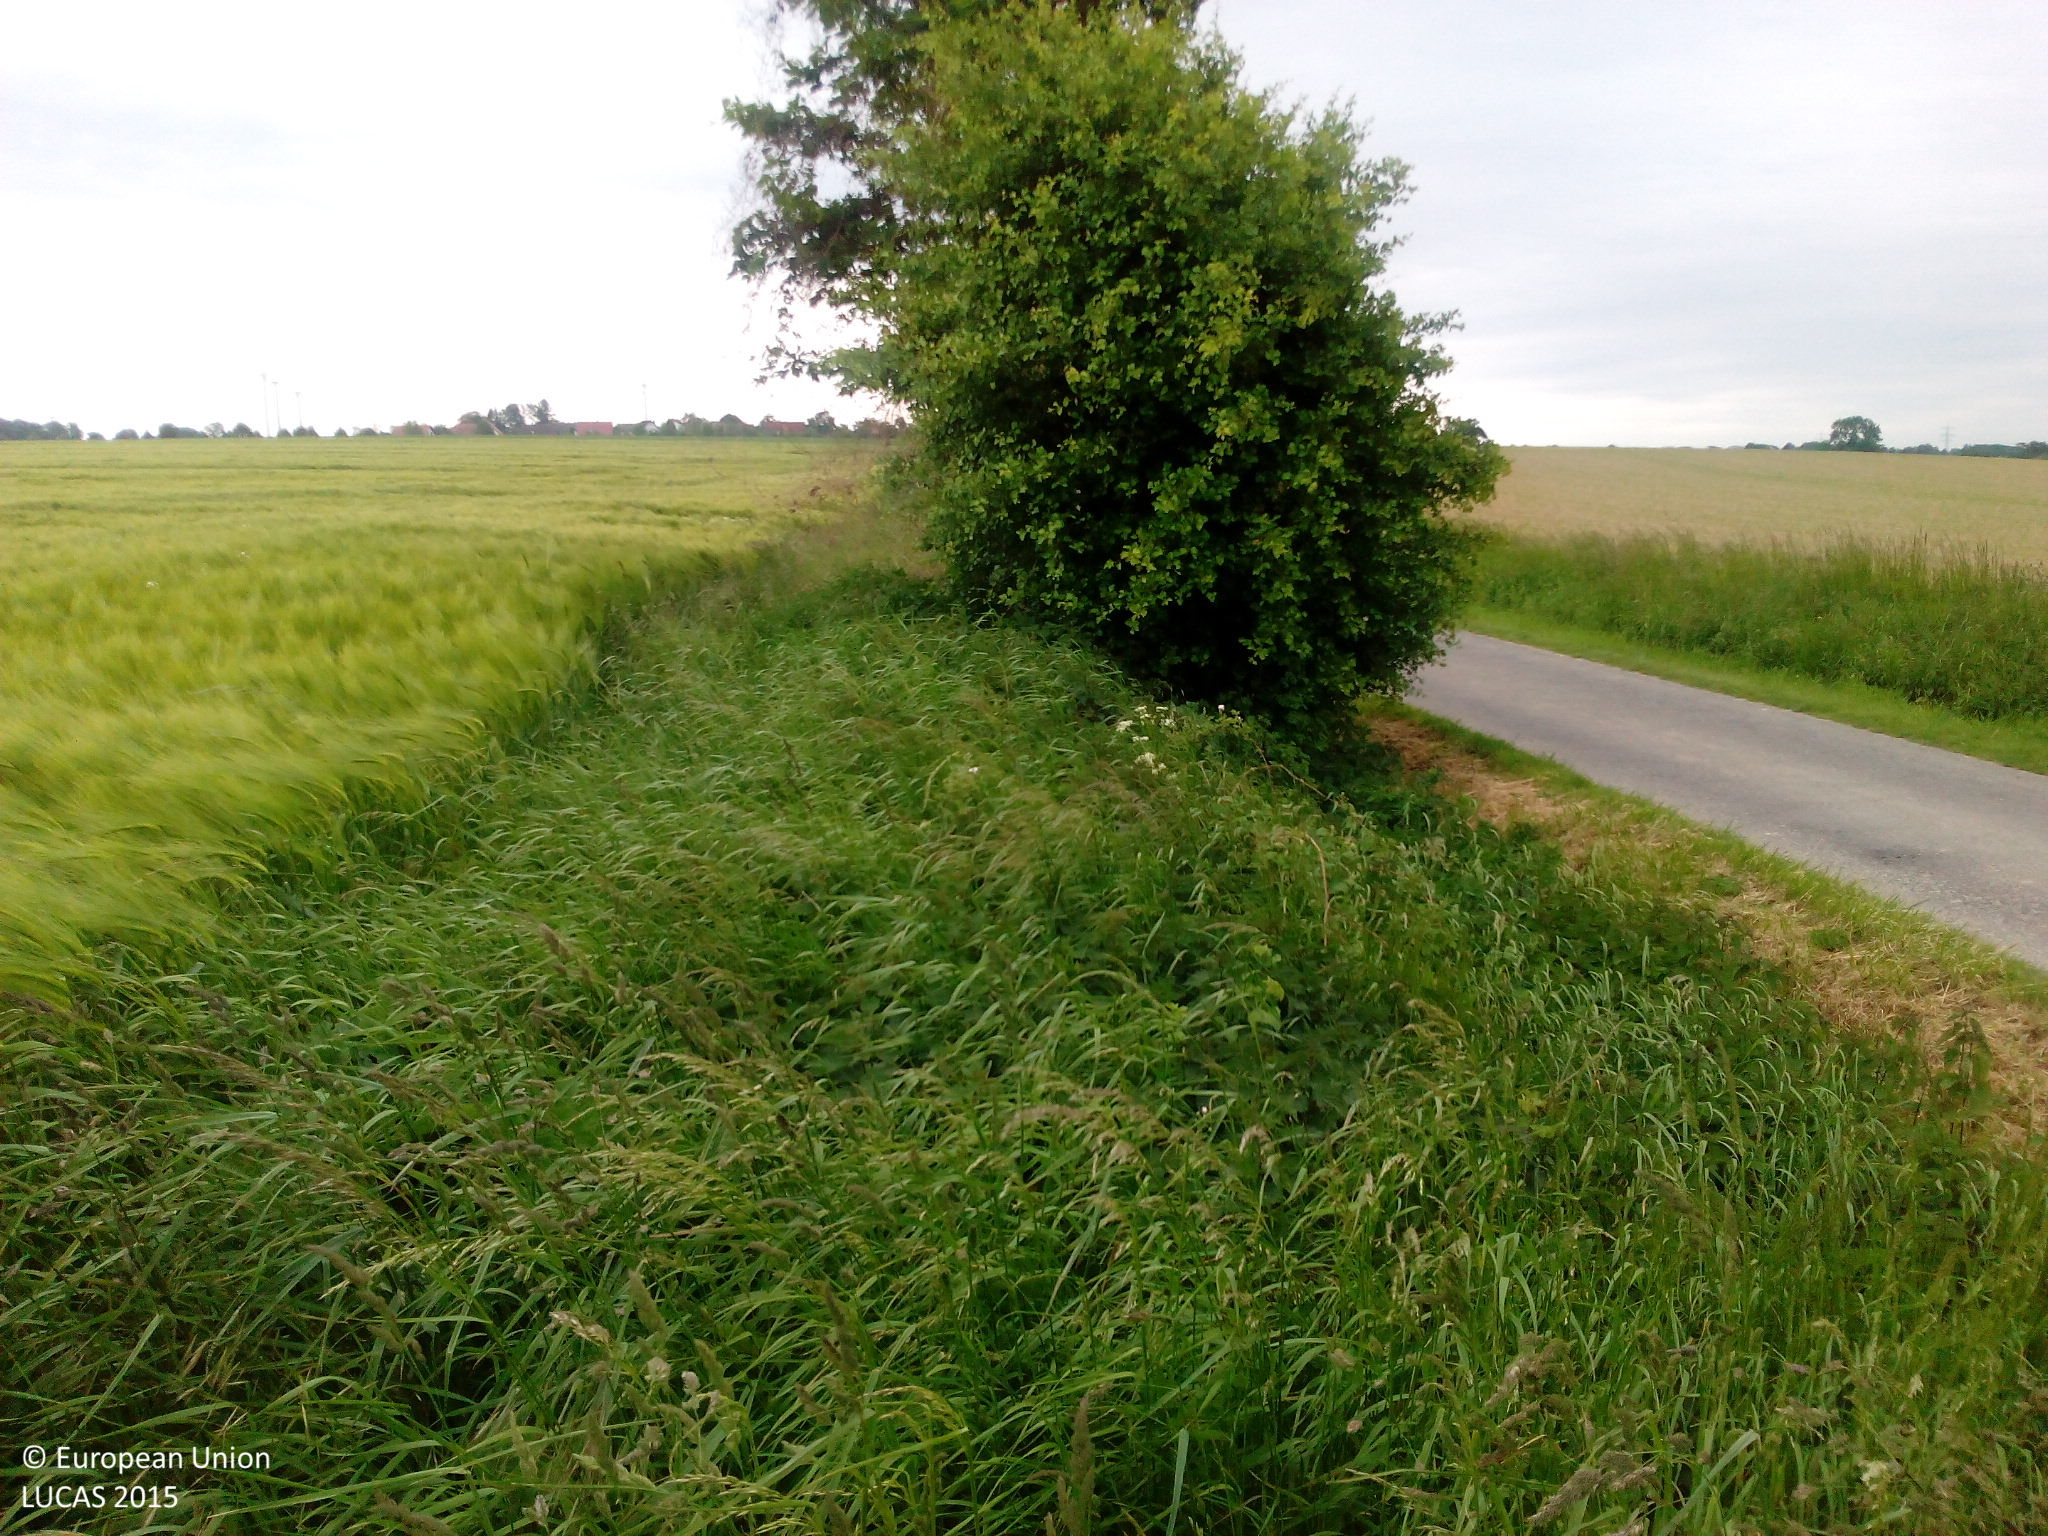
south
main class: Cropland
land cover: Barley
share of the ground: > 75 %
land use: Agriculture (excluding fallow land and kitchen gardens)
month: June
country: DE
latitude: 51.5155
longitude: 7.9973
